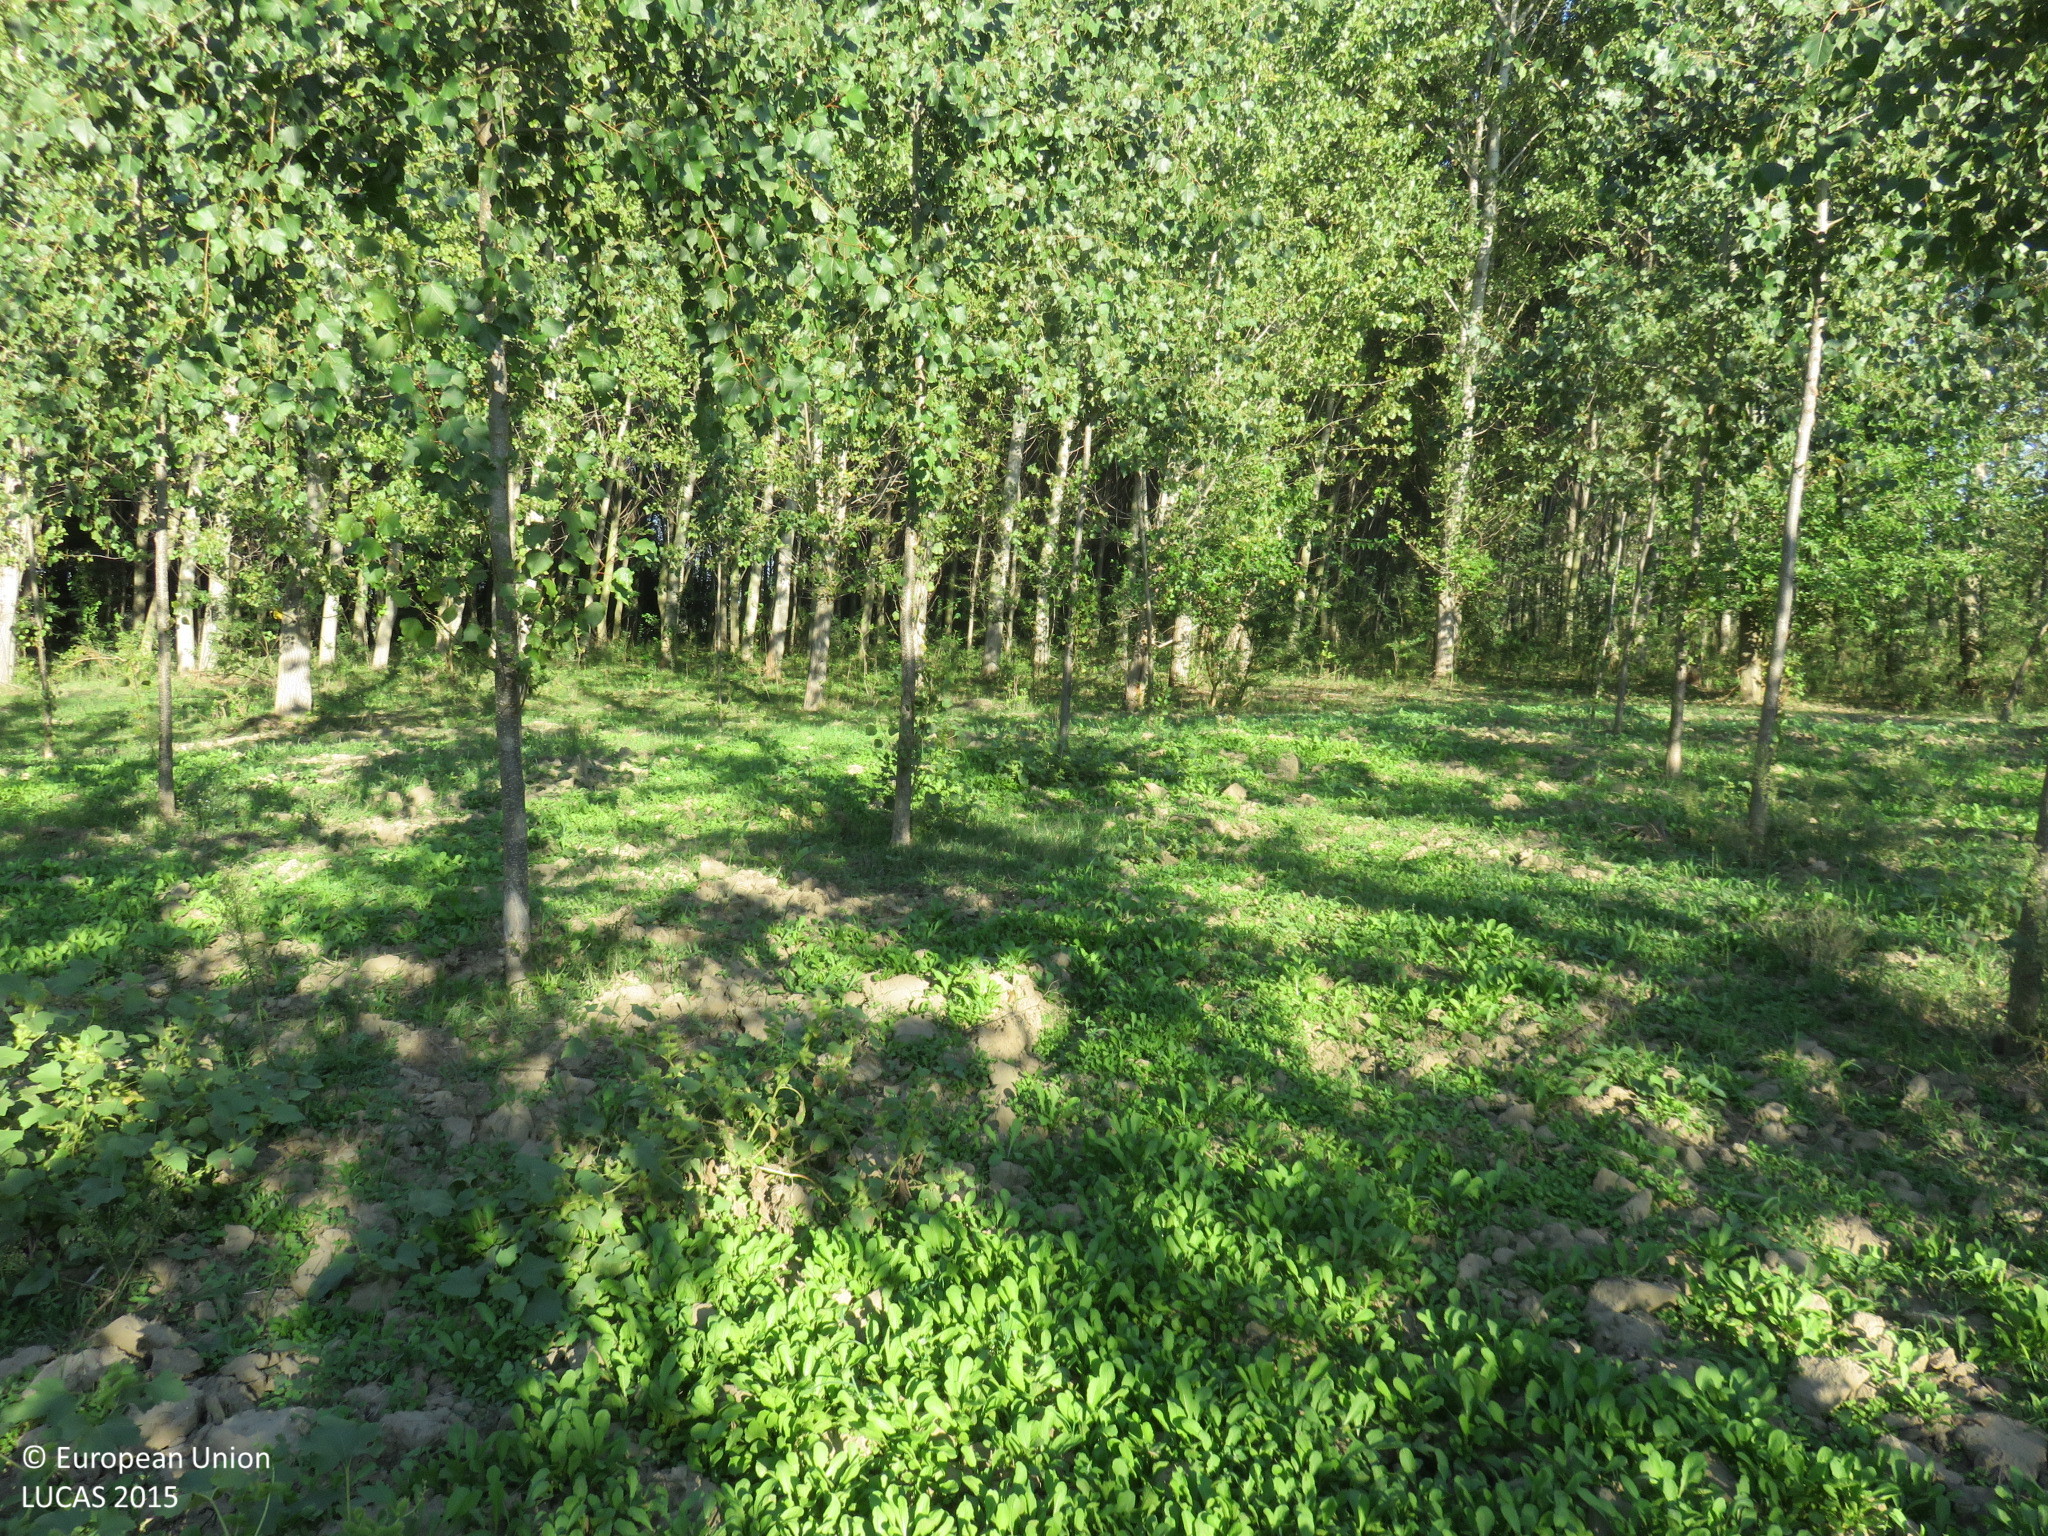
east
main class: Woodland
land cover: Broadleaved woodland
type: floodplain forest
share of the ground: 50 - 75 %
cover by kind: broadleaved forest trees 60 %, herbaceous plants 40 %
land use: Forestry
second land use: Protection infrastructures
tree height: < 5 m
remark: Nursery
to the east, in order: Broadleaved woodland; Spontaneously vegetated surfaces; Tracks; Broadleaved woodland; Tracks; Broadleaved woodland
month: September
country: BG
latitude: 43.7140
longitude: 24.9791
